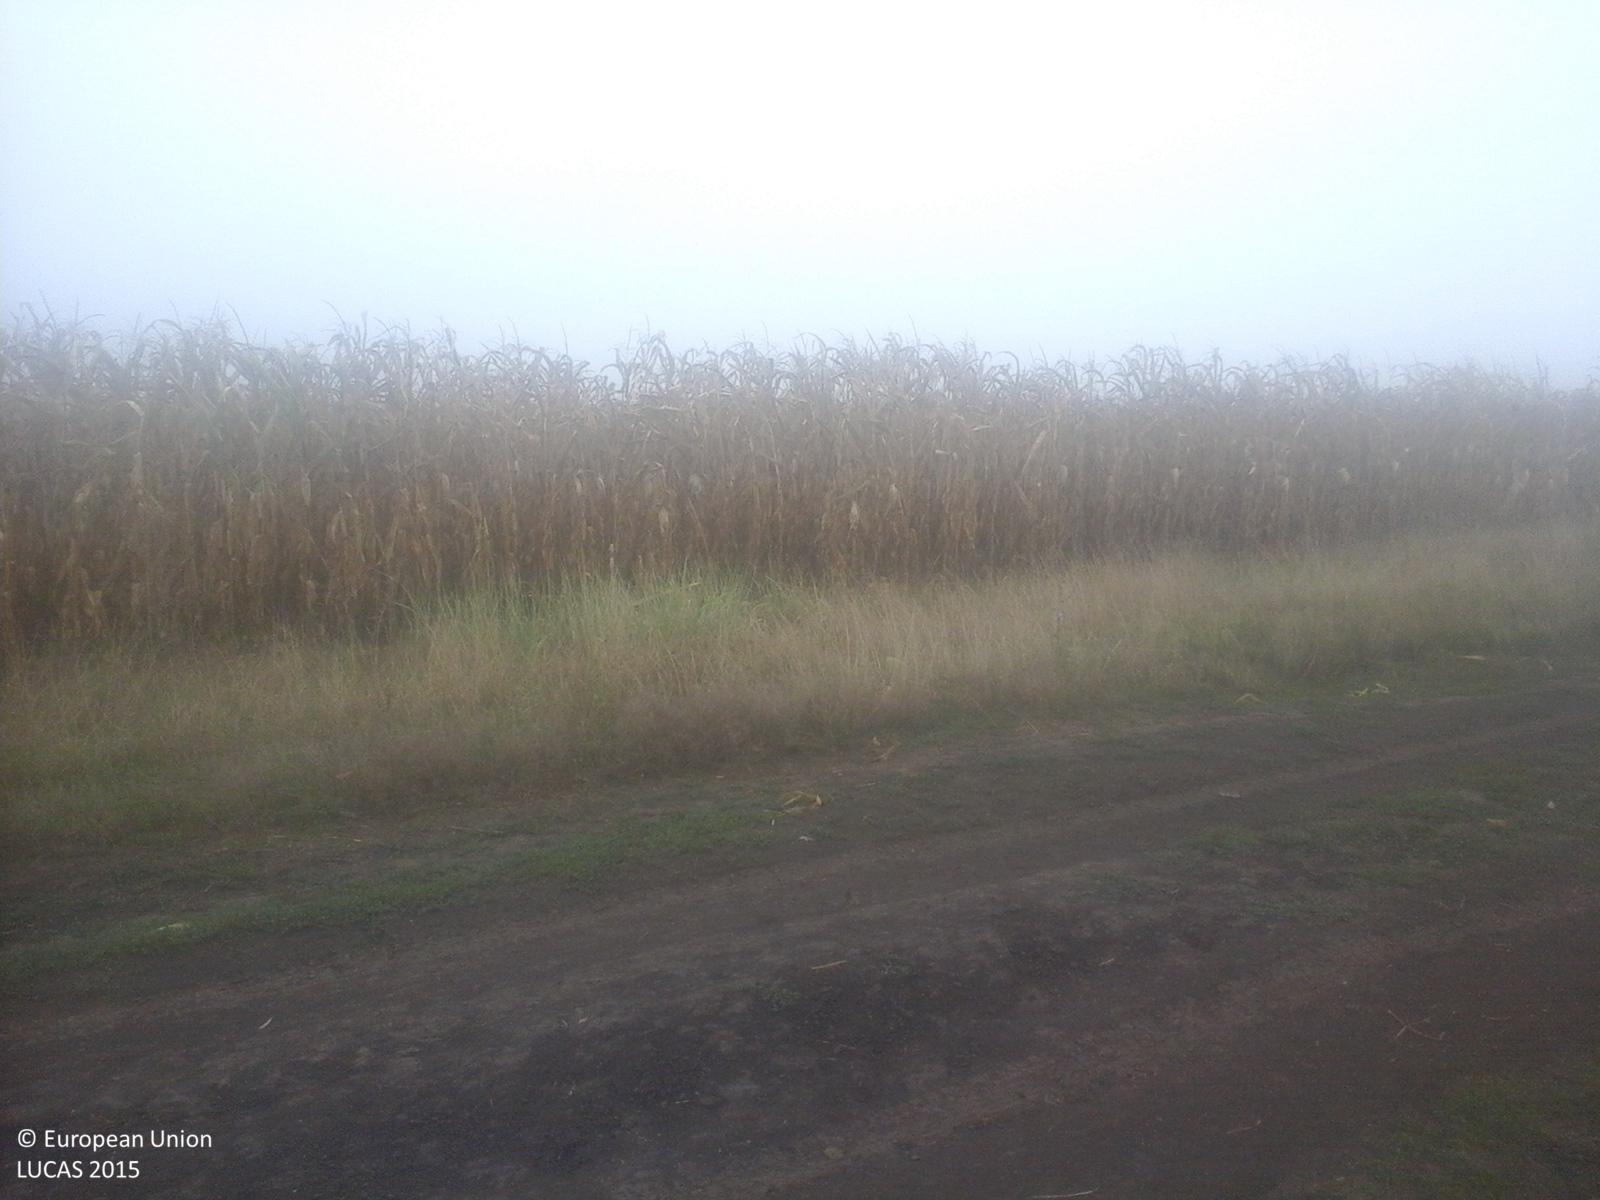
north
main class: Grassland
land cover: Grassland without tree/shrub cover
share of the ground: > 75 %
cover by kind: herbaceous plants 100 %
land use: Agriculture (excluding fallow land and kitchen gardens)
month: September
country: RO
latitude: 47.5003
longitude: 22.4150
